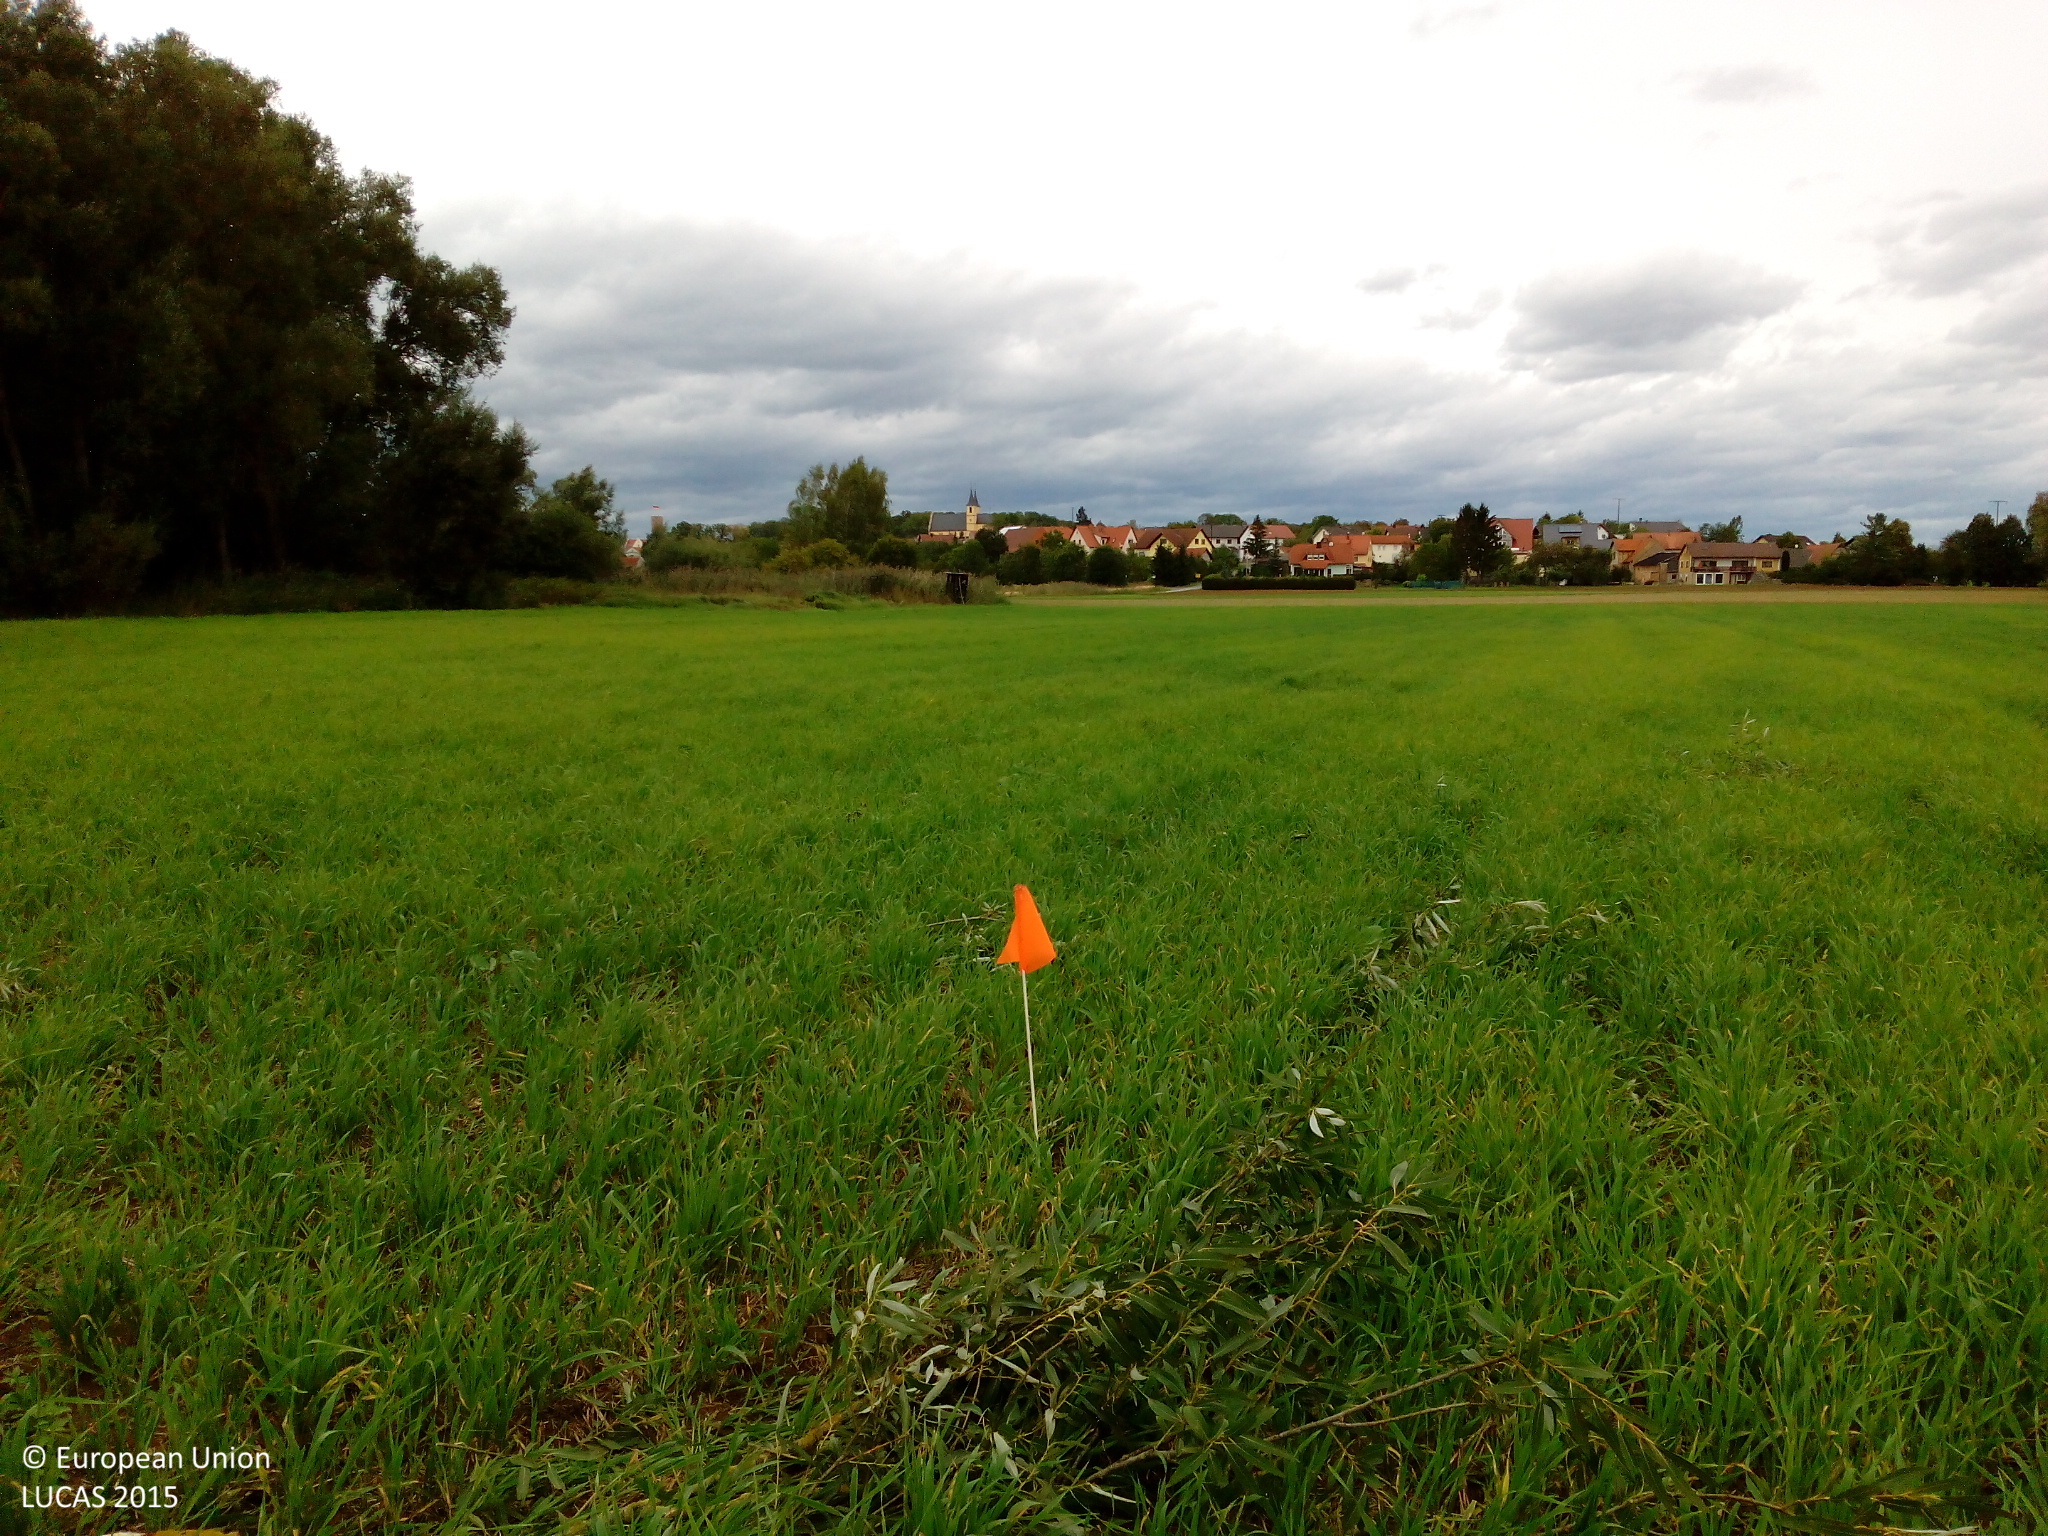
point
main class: Cropland
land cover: Barley
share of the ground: 50 - 75 %
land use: Agriculture (excluding fallow land and kitchen gardens)
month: September
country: DE
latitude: 50.0044
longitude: 9.9582
